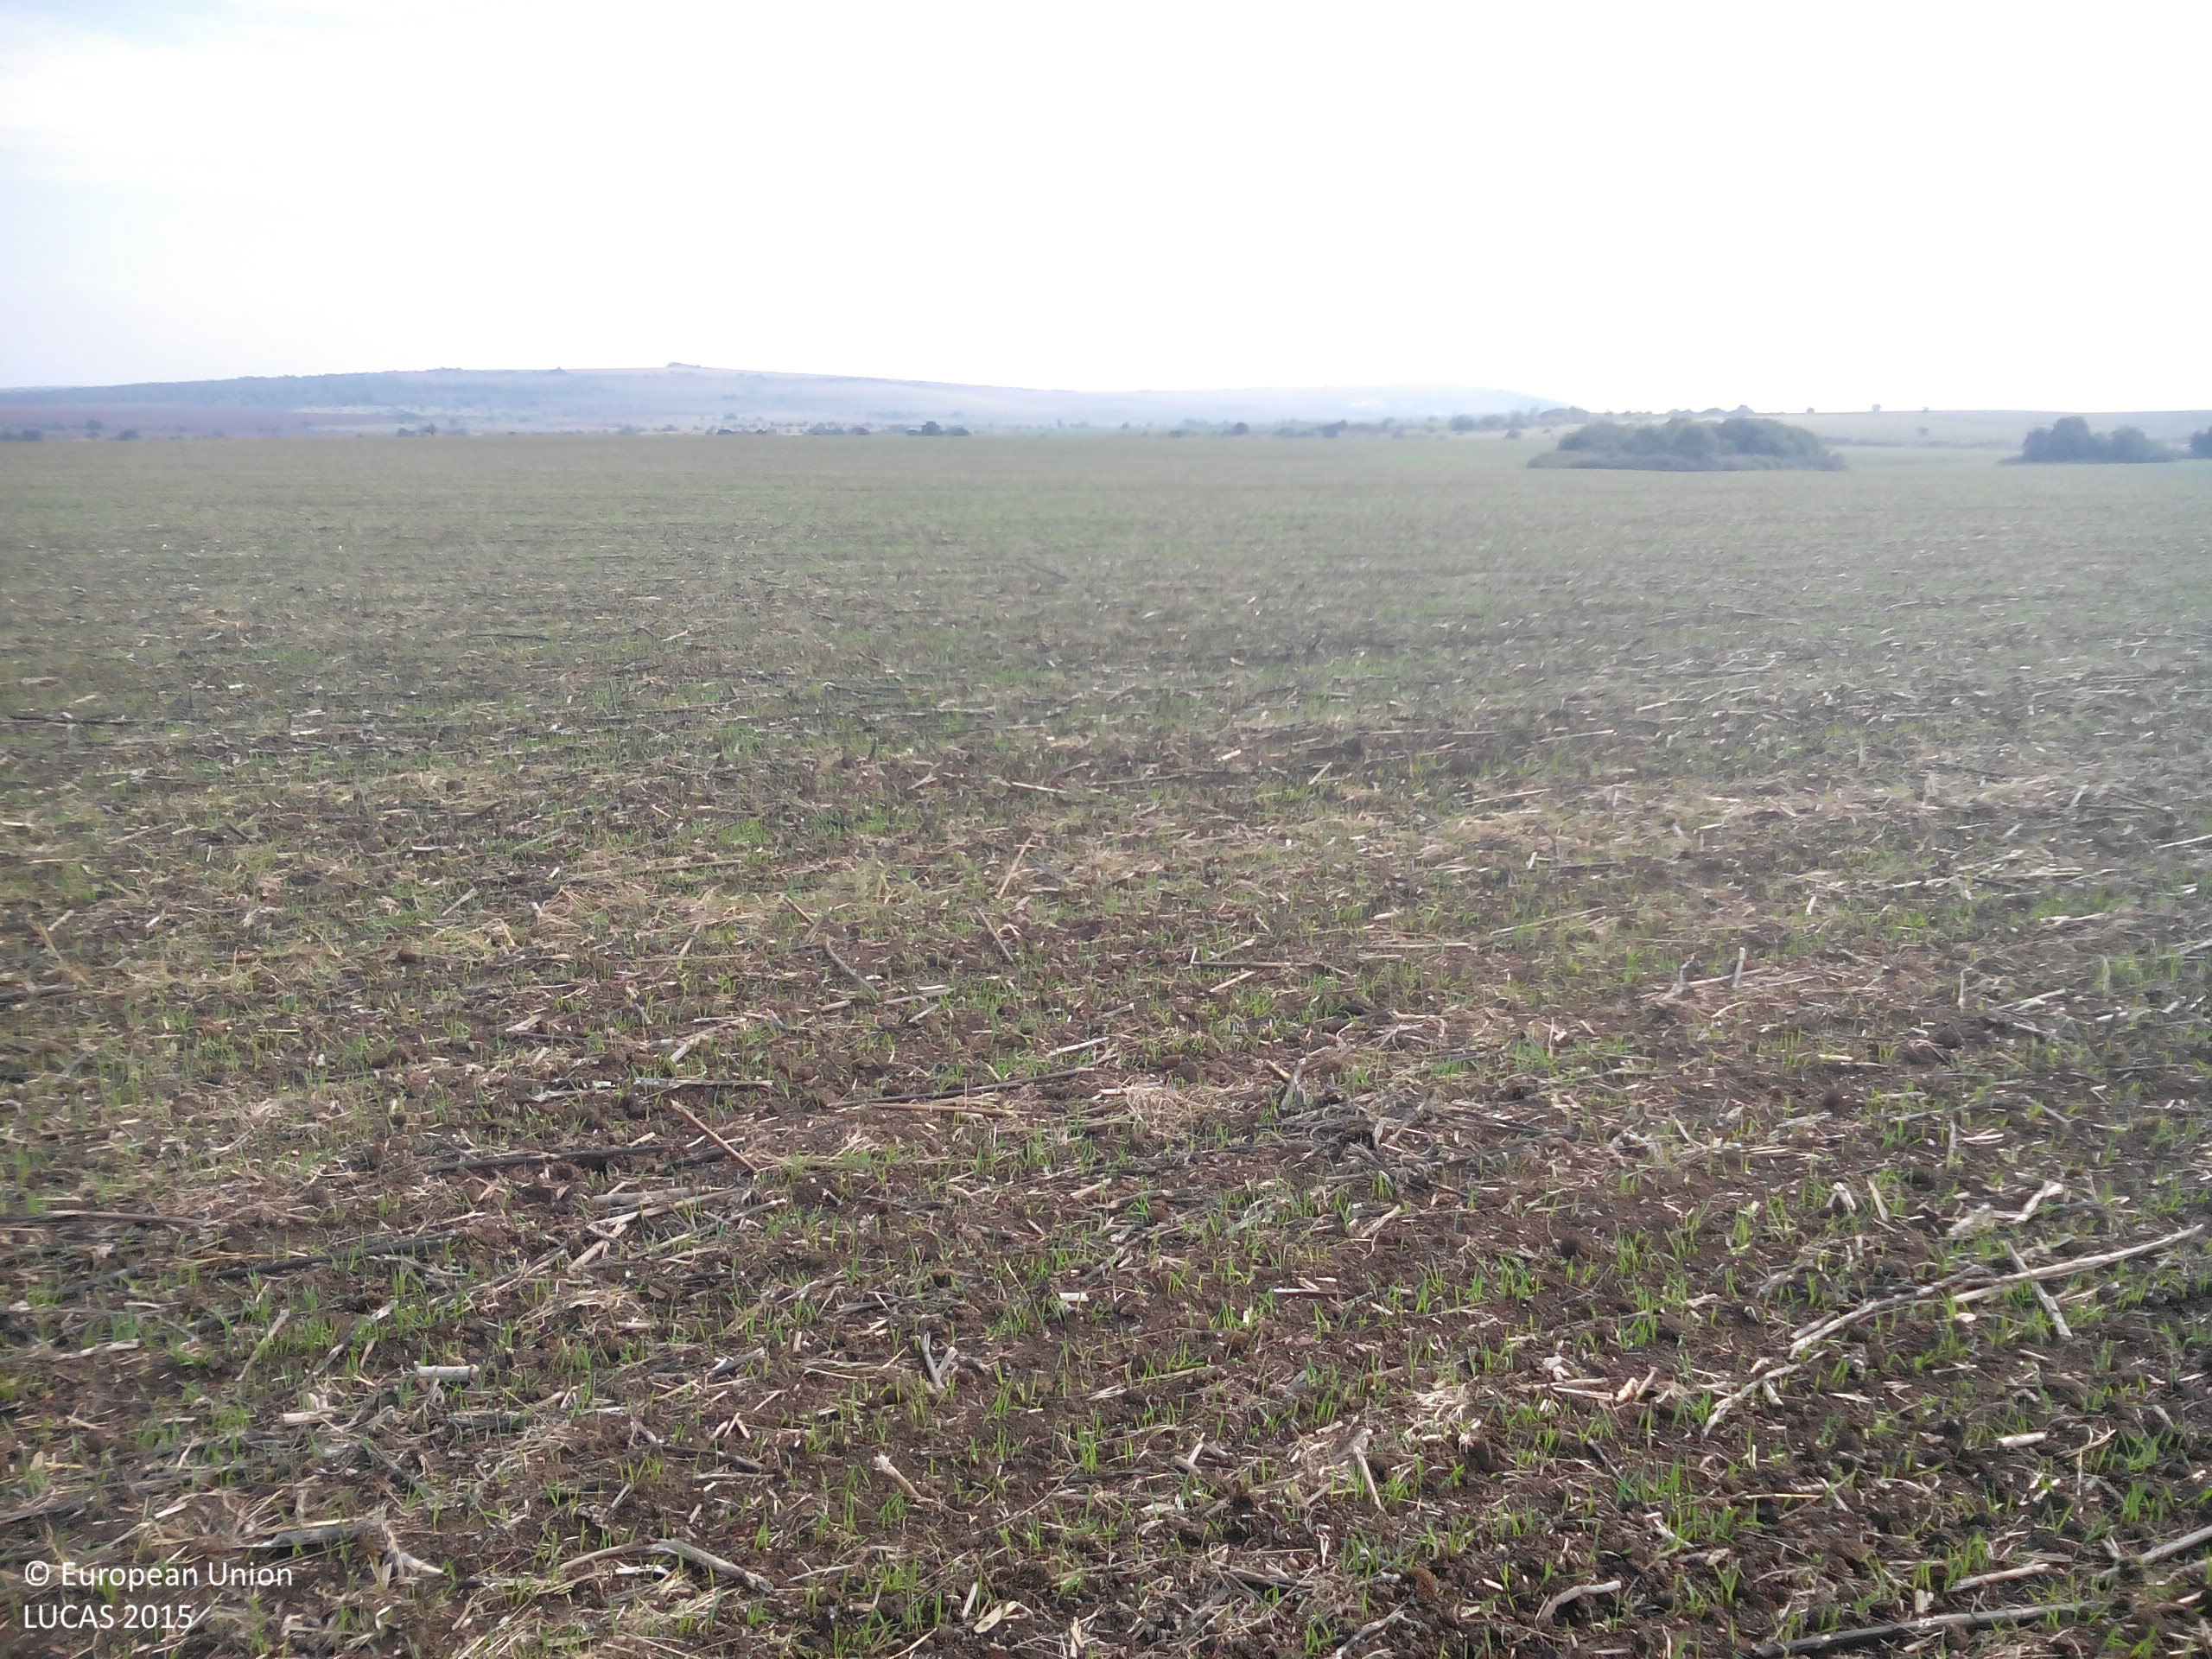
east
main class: Cropland
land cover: Common wheat
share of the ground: 10 - 25 %
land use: Agriculture (excluding fallow land and kitchen gardens)
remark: Harvested field
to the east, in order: Common wheat
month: October
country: BG
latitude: 43.2026
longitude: 23.9438
